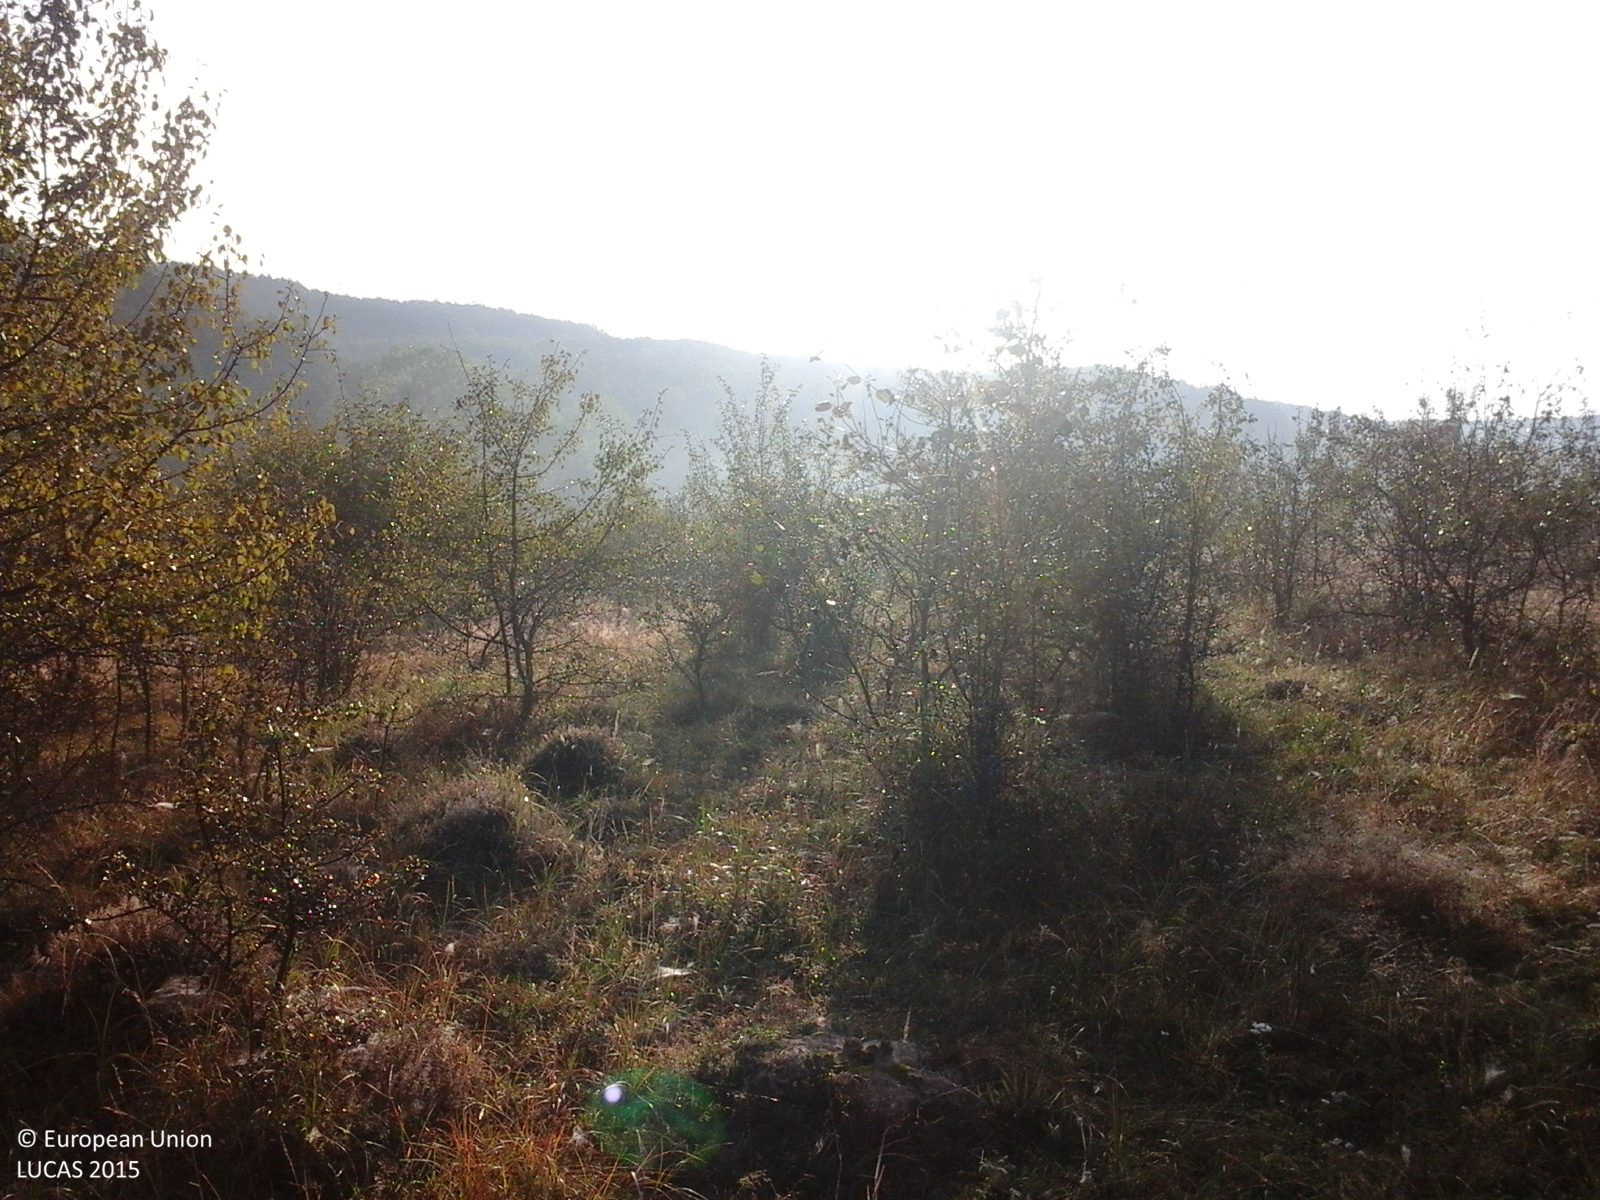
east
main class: Grassland
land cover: Grassland with sparse tree/shrub cover
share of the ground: > 75 %
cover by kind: herbaceous plants 85 %, shrubs 10 %, broadleaved forest trees 5 %
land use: Agriculture (excluding fallow land and kitchen gardens)
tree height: > 5 m
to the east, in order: Grassland with sparse tree/shrub cover; Tracks; Abandoned hedges; Tracks; Grassland with sparse tree/shrub cover; Ditches and canals; Grassland with sparse tree/shrub cover
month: September
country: RO
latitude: 46.8947
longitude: 23.3638
